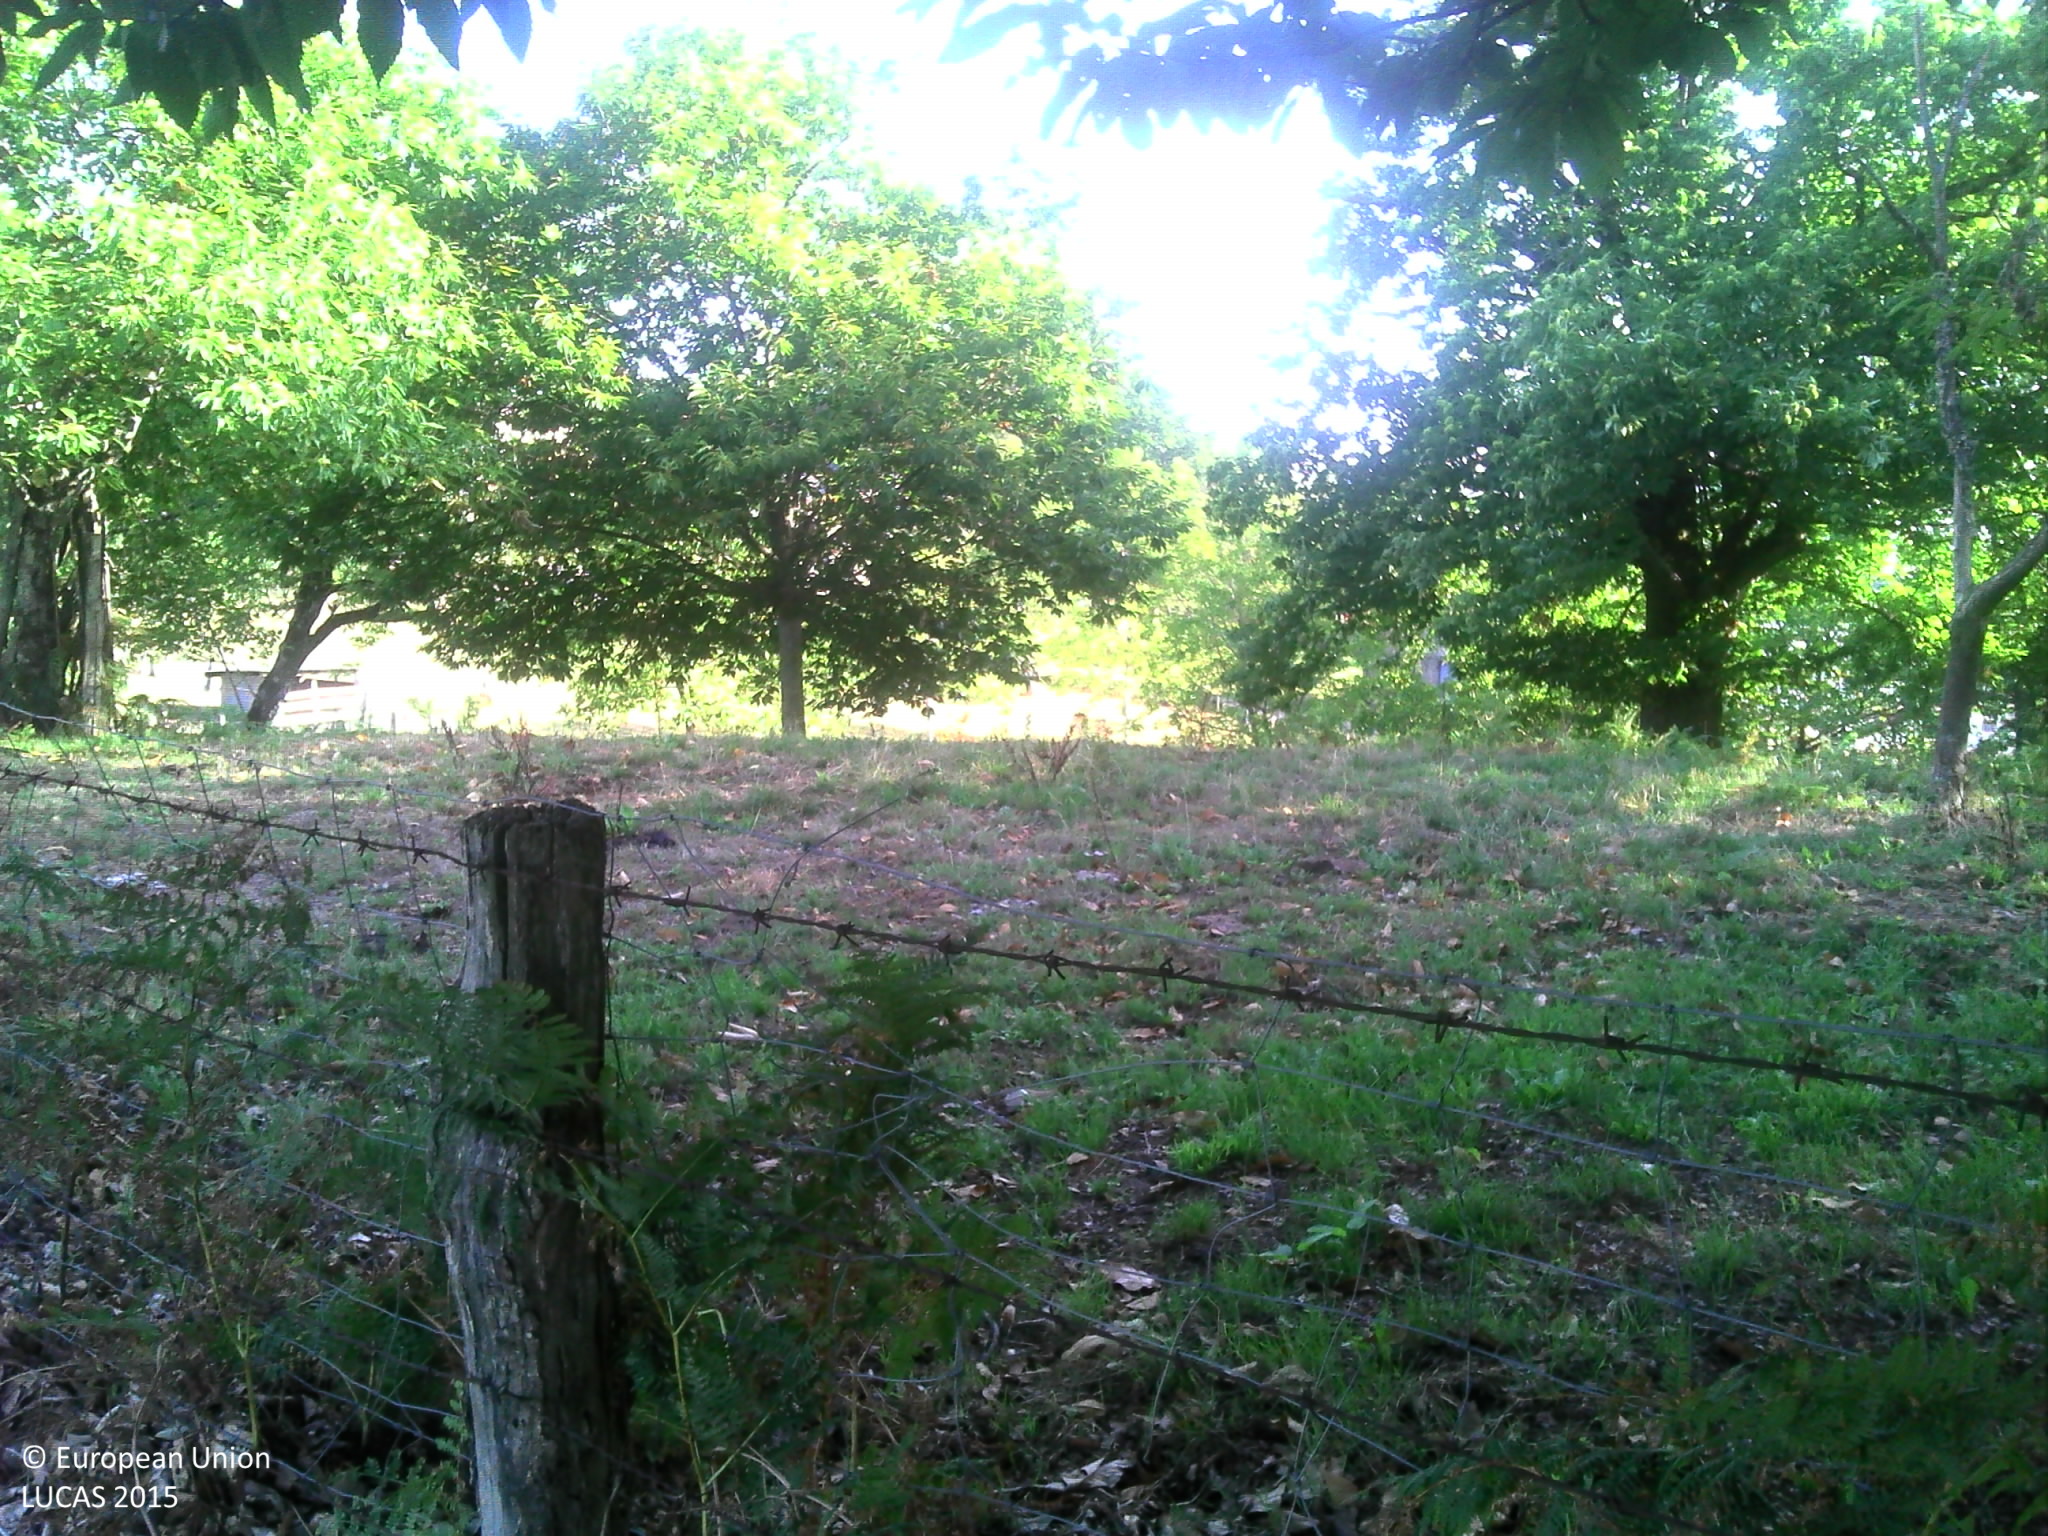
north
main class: Woodland
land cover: Broadleaved woodland
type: thermophilous deciduous forest
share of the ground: 25 - 50 %
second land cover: Grassland without tree/shrub cover
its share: > 75 %
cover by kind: herbaceous plants 60 %, broadleaved forest trees 40 %
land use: Forestry
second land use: Agriculture (excluding fallow land and kitchen gardens)
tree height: > 5 m
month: August
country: FR
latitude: 45.2892
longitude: 1.5158
